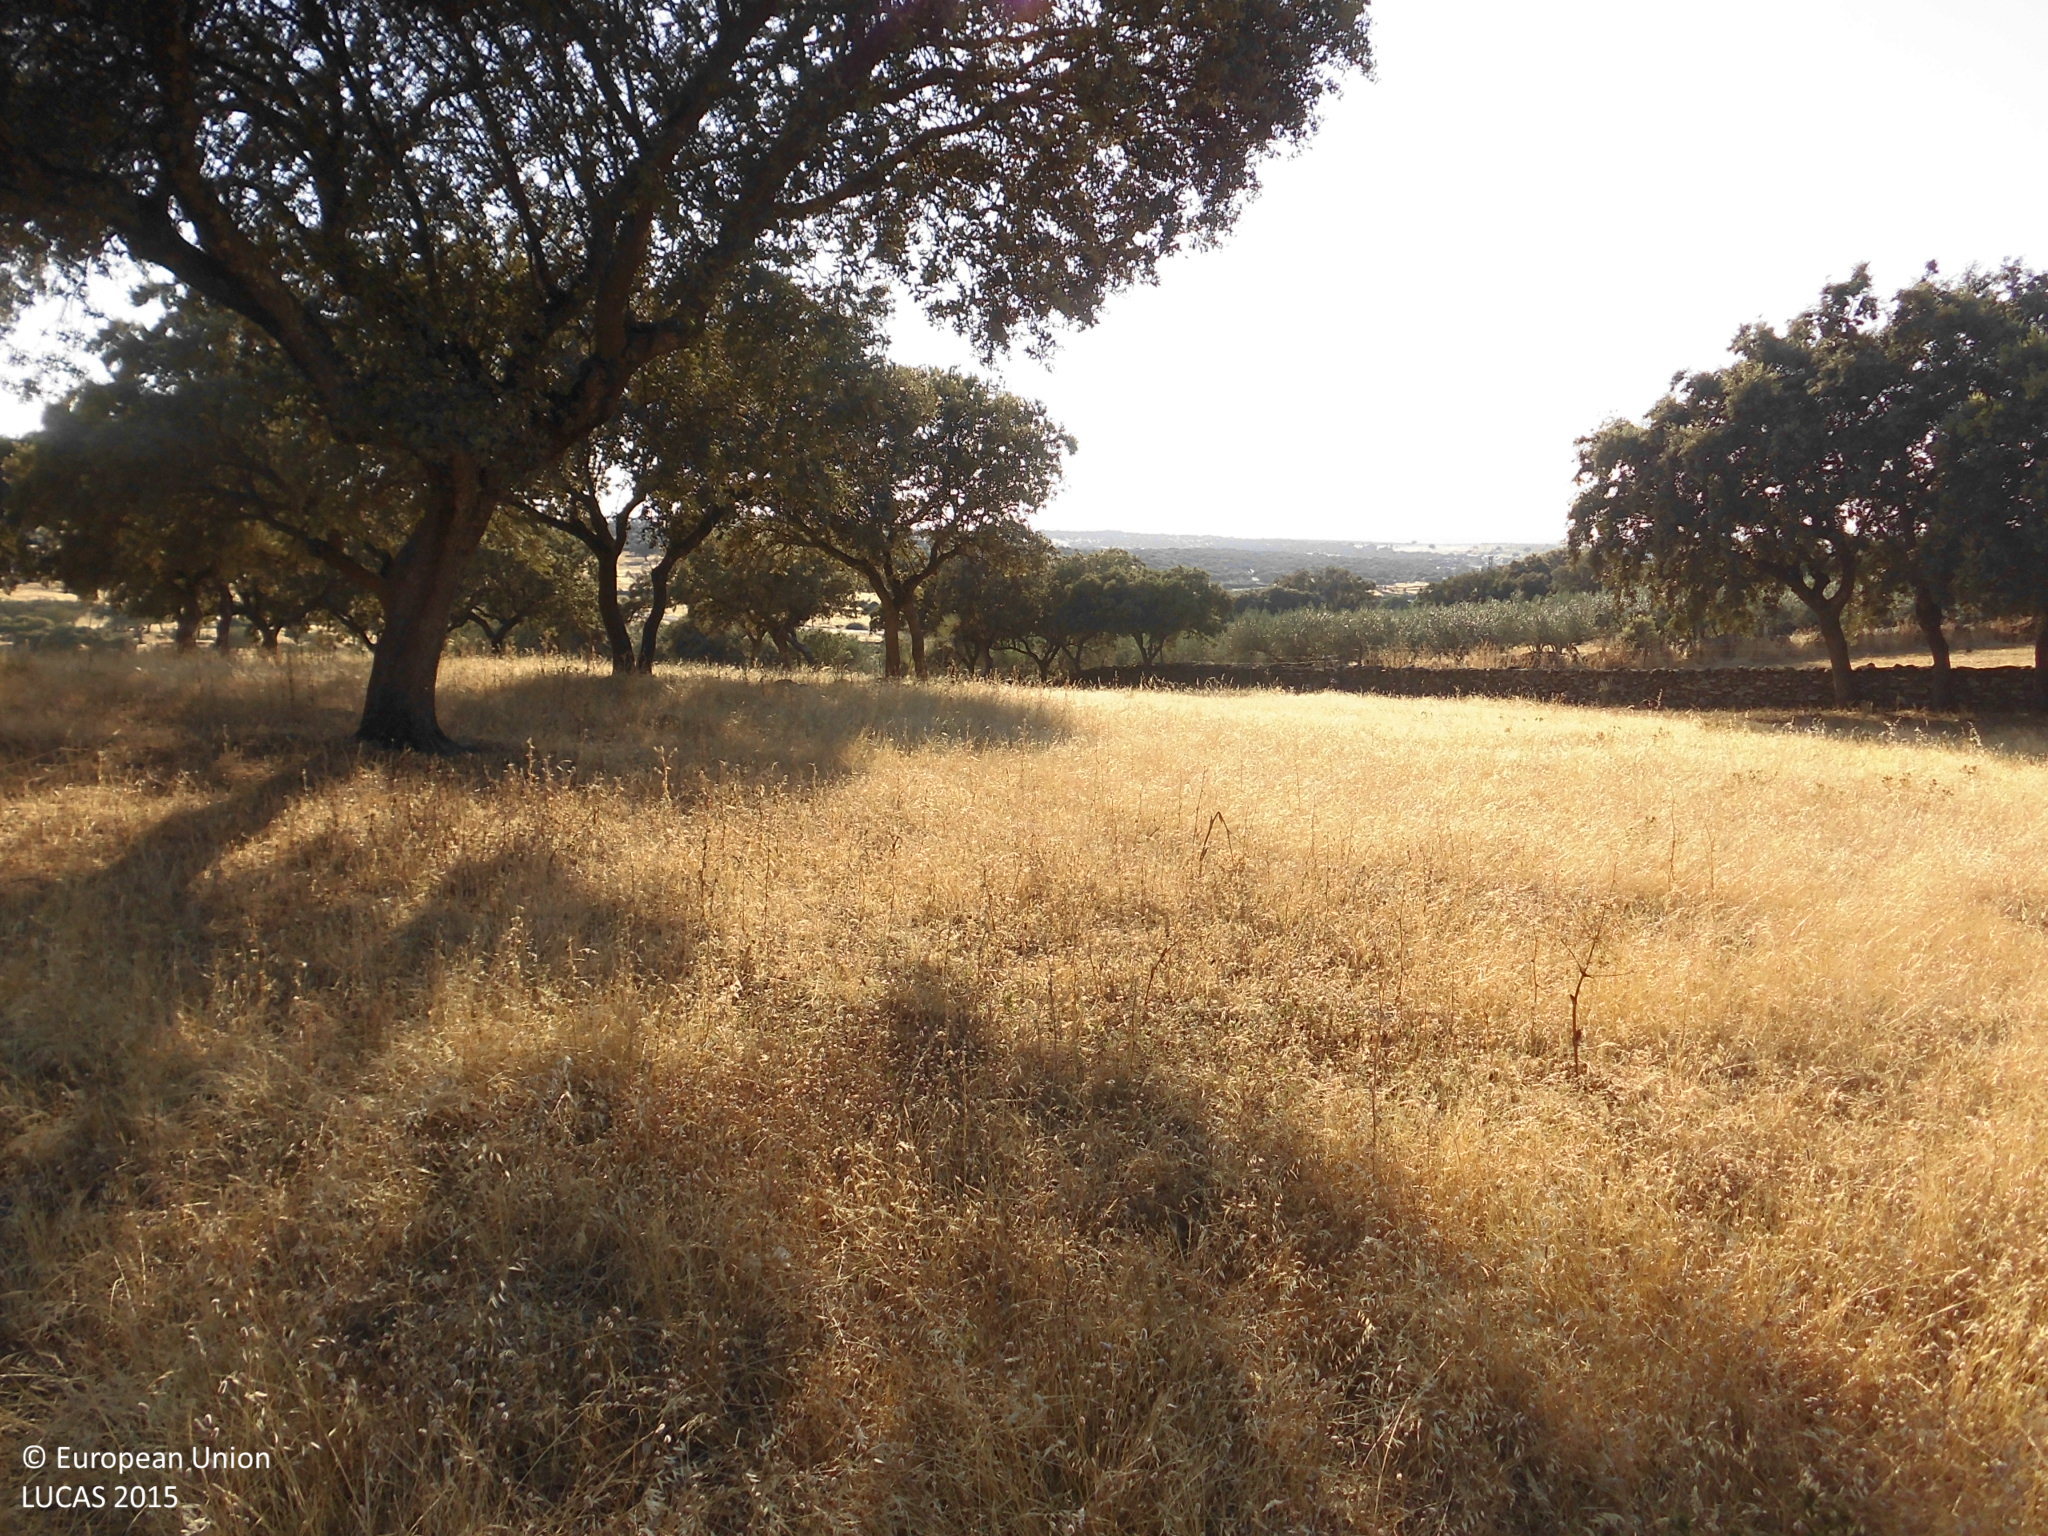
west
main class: Grassland
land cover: Grassland with sparse tree/shrub cover
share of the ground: > 75 %
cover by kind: herbaceous plants 95 %, broadleaved forest trees 5 %
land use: Agriculture (excluding fallow land and kitchen gardens)
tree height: > 5 m
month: July
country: ES
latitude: 39.5208
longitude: -5.6304
